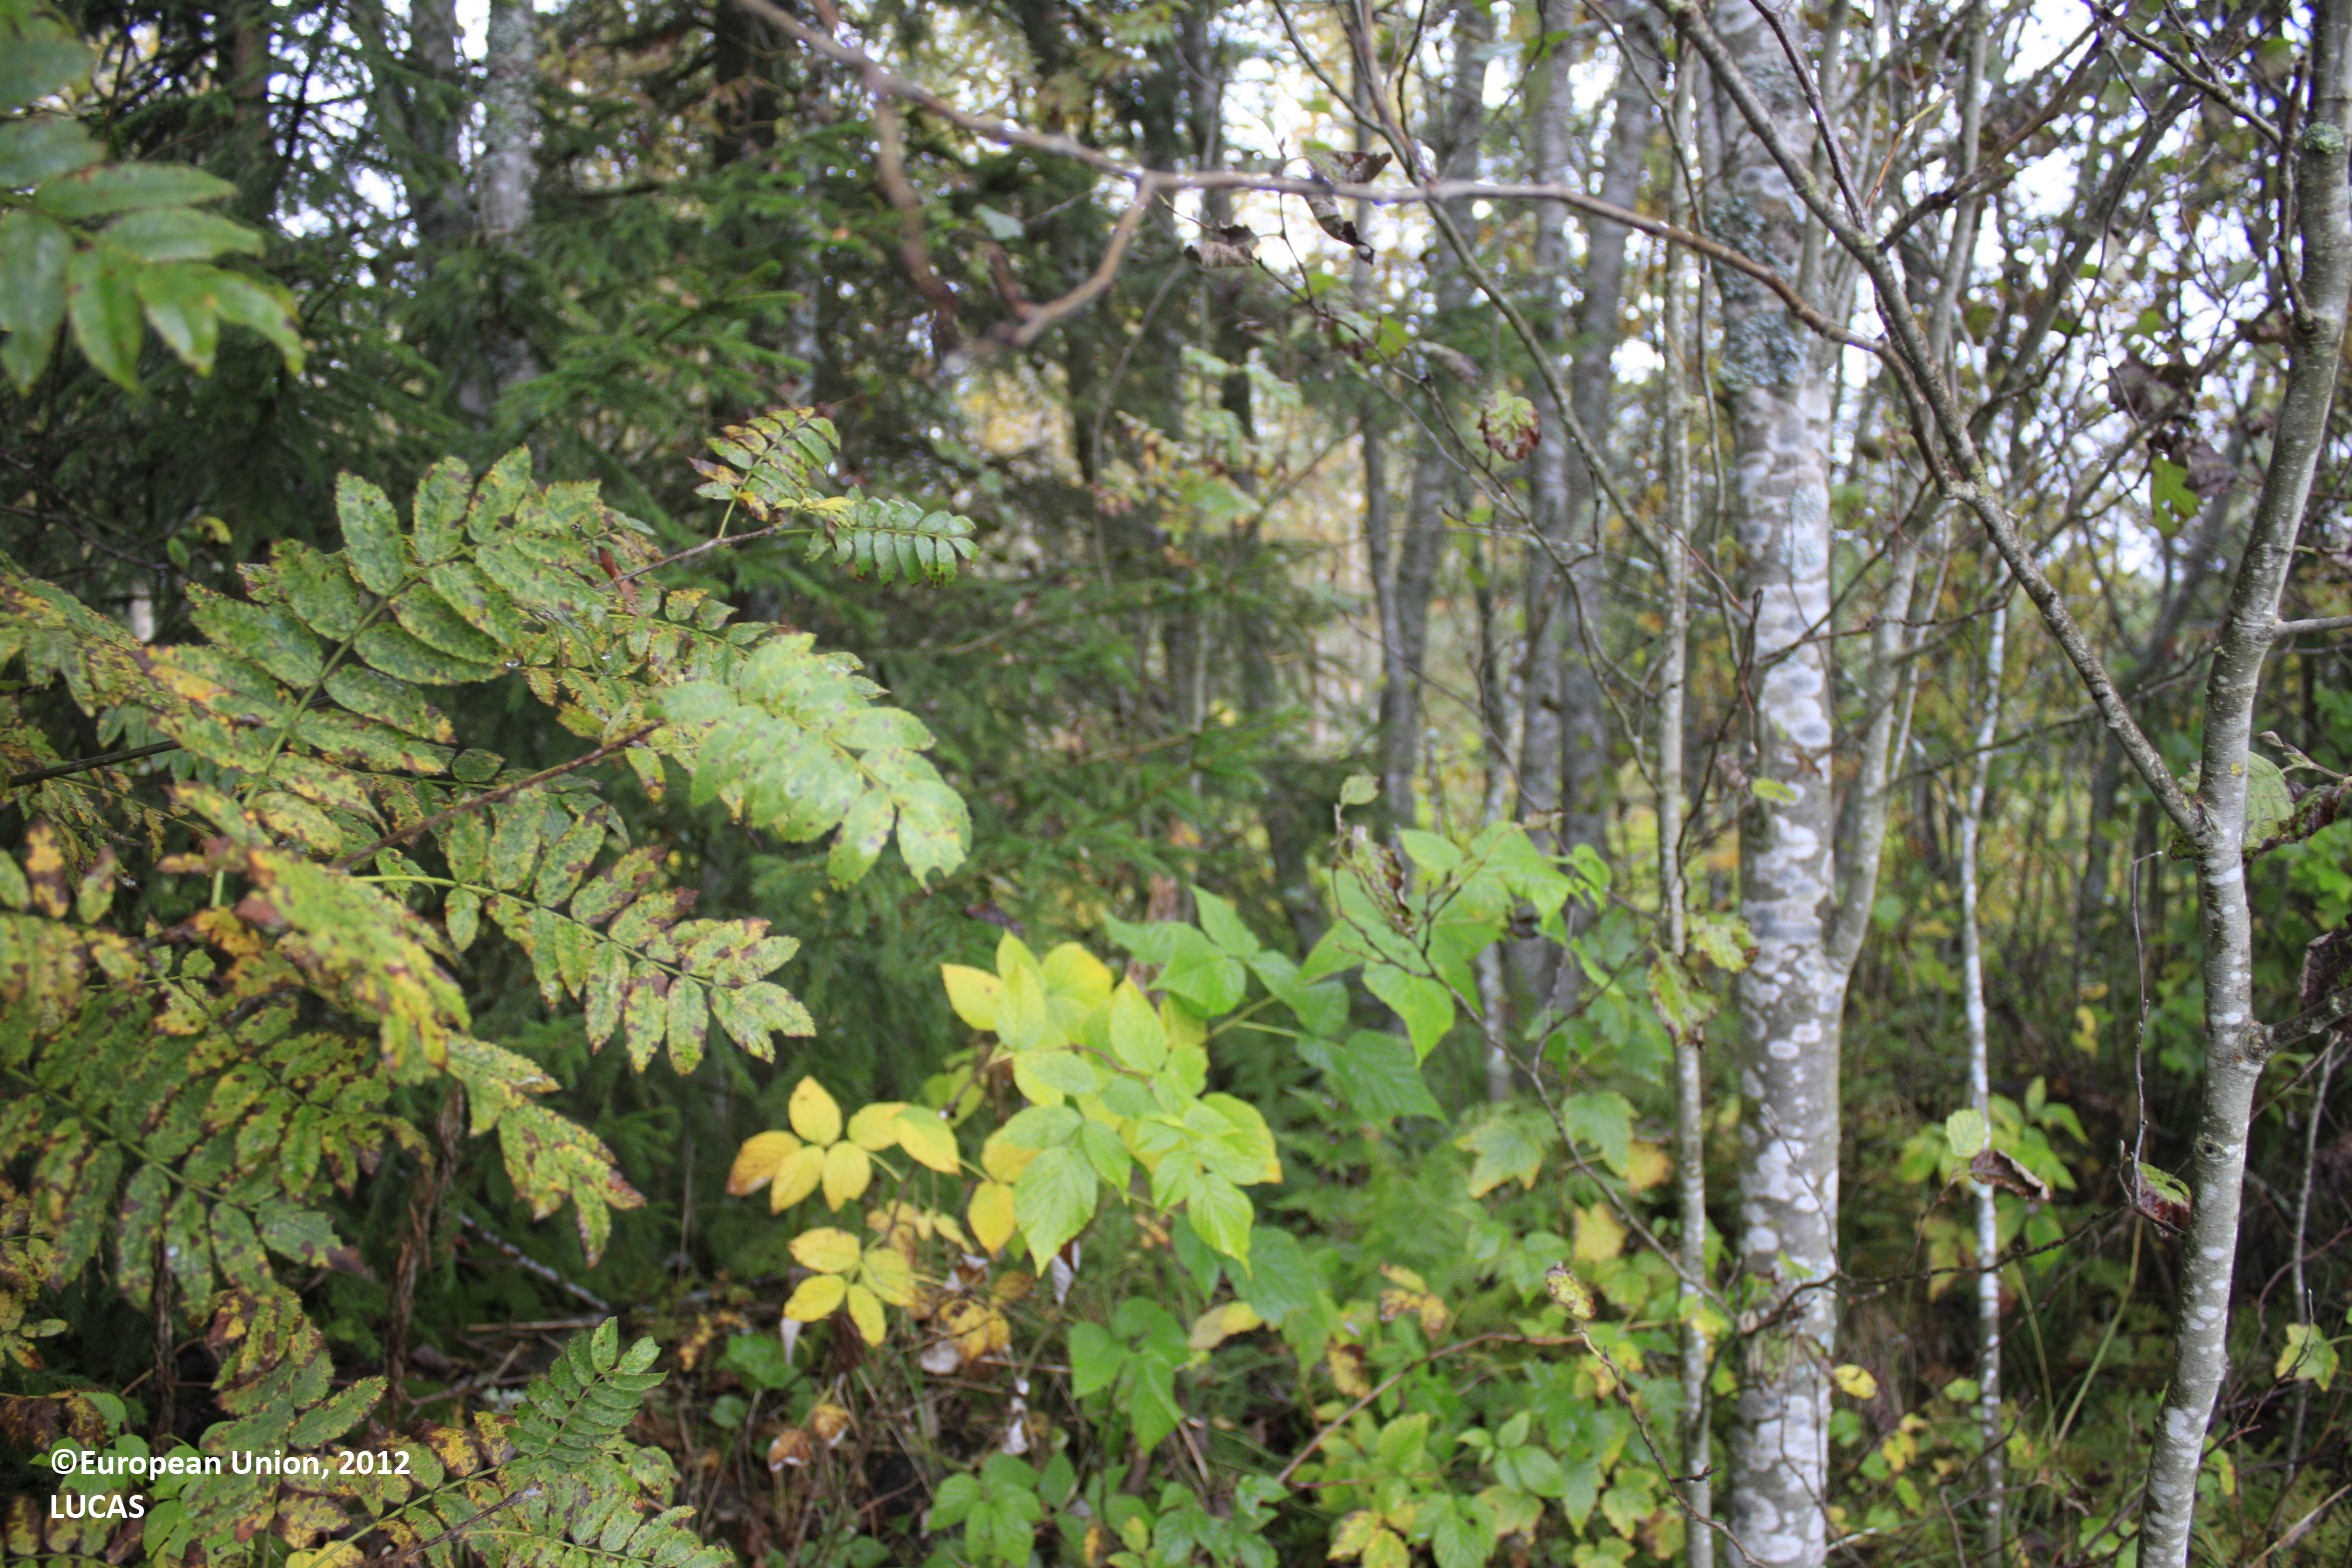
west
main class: Woodland
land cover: Spruce dominated mixed woodland
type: boreal forest
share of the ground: 50 - 75 %
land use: Forestry
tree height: > 5 m
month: September
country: FI
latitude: 63.6559
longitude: 25.9663
